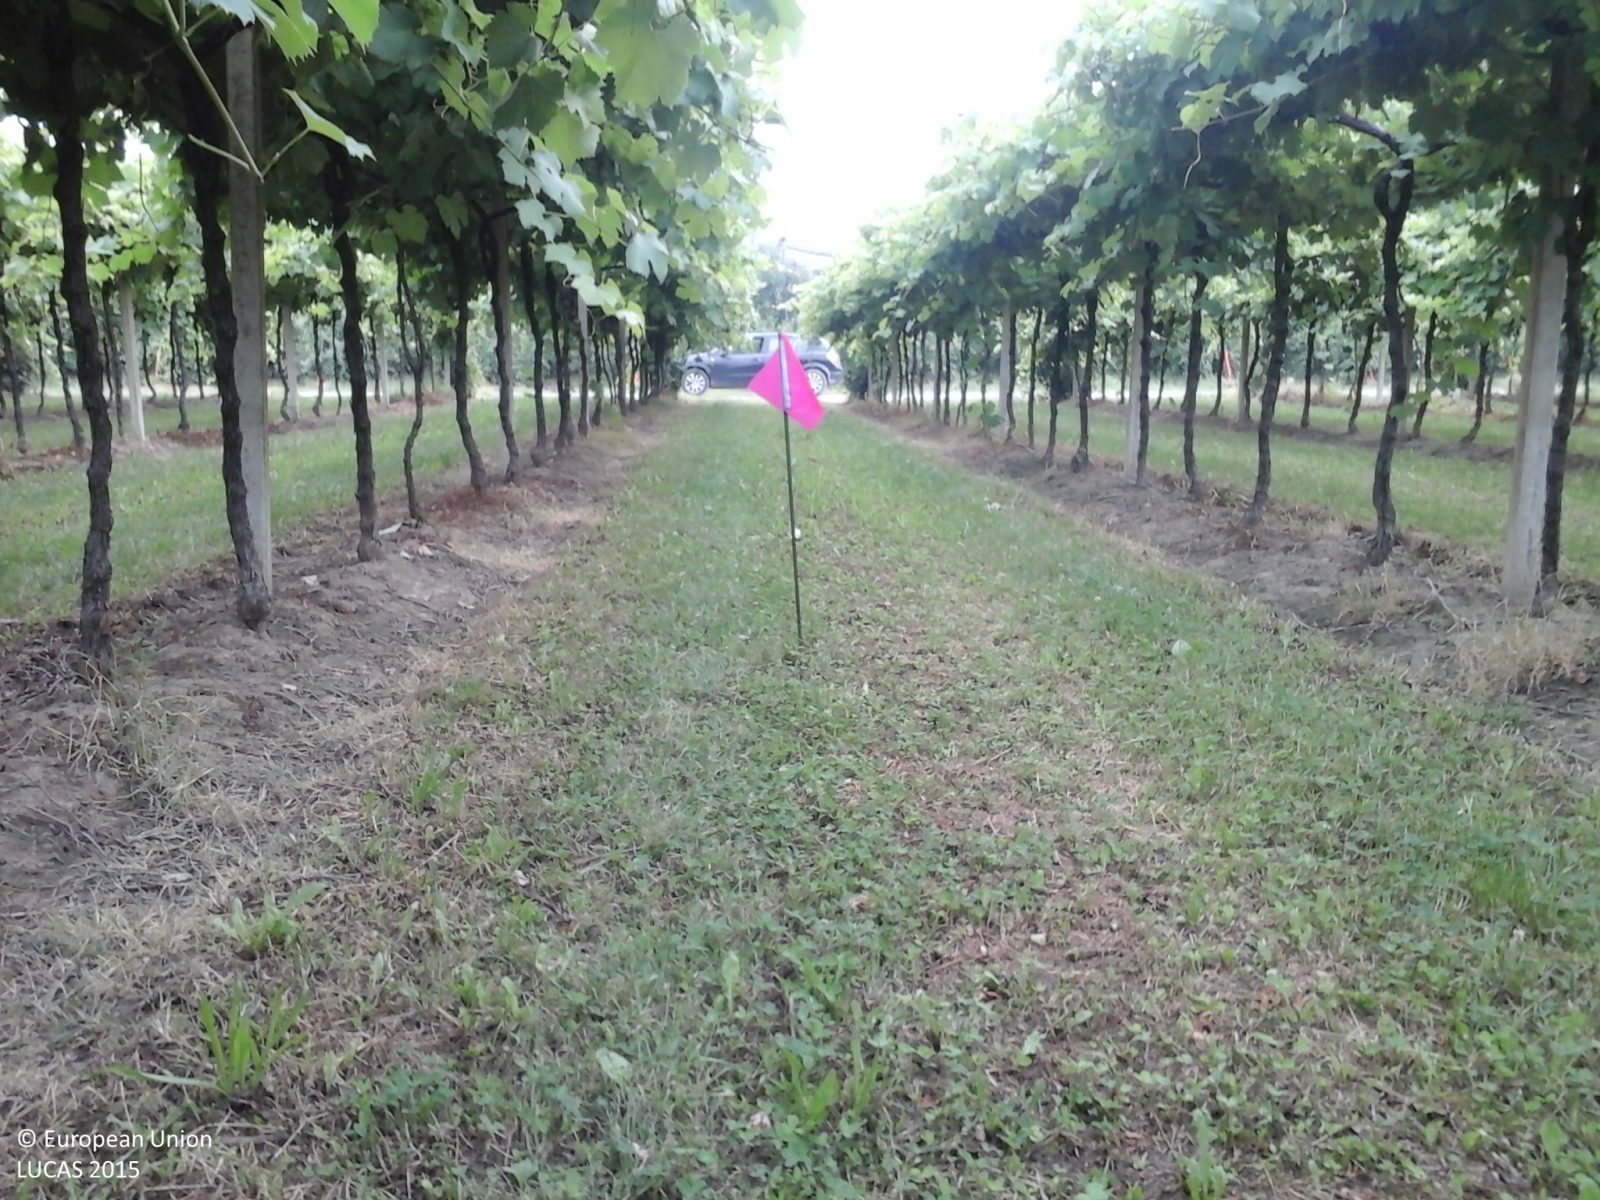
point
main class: Cropland
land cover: Vineyards
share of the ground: 50 - 75 %
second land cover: Grassland without tree/shrub cover
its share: > 75 %
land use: Agriculture (excluding fallow land and kitchen gardens)
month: June
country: IT
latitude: 44.7062
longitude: 11.0202
